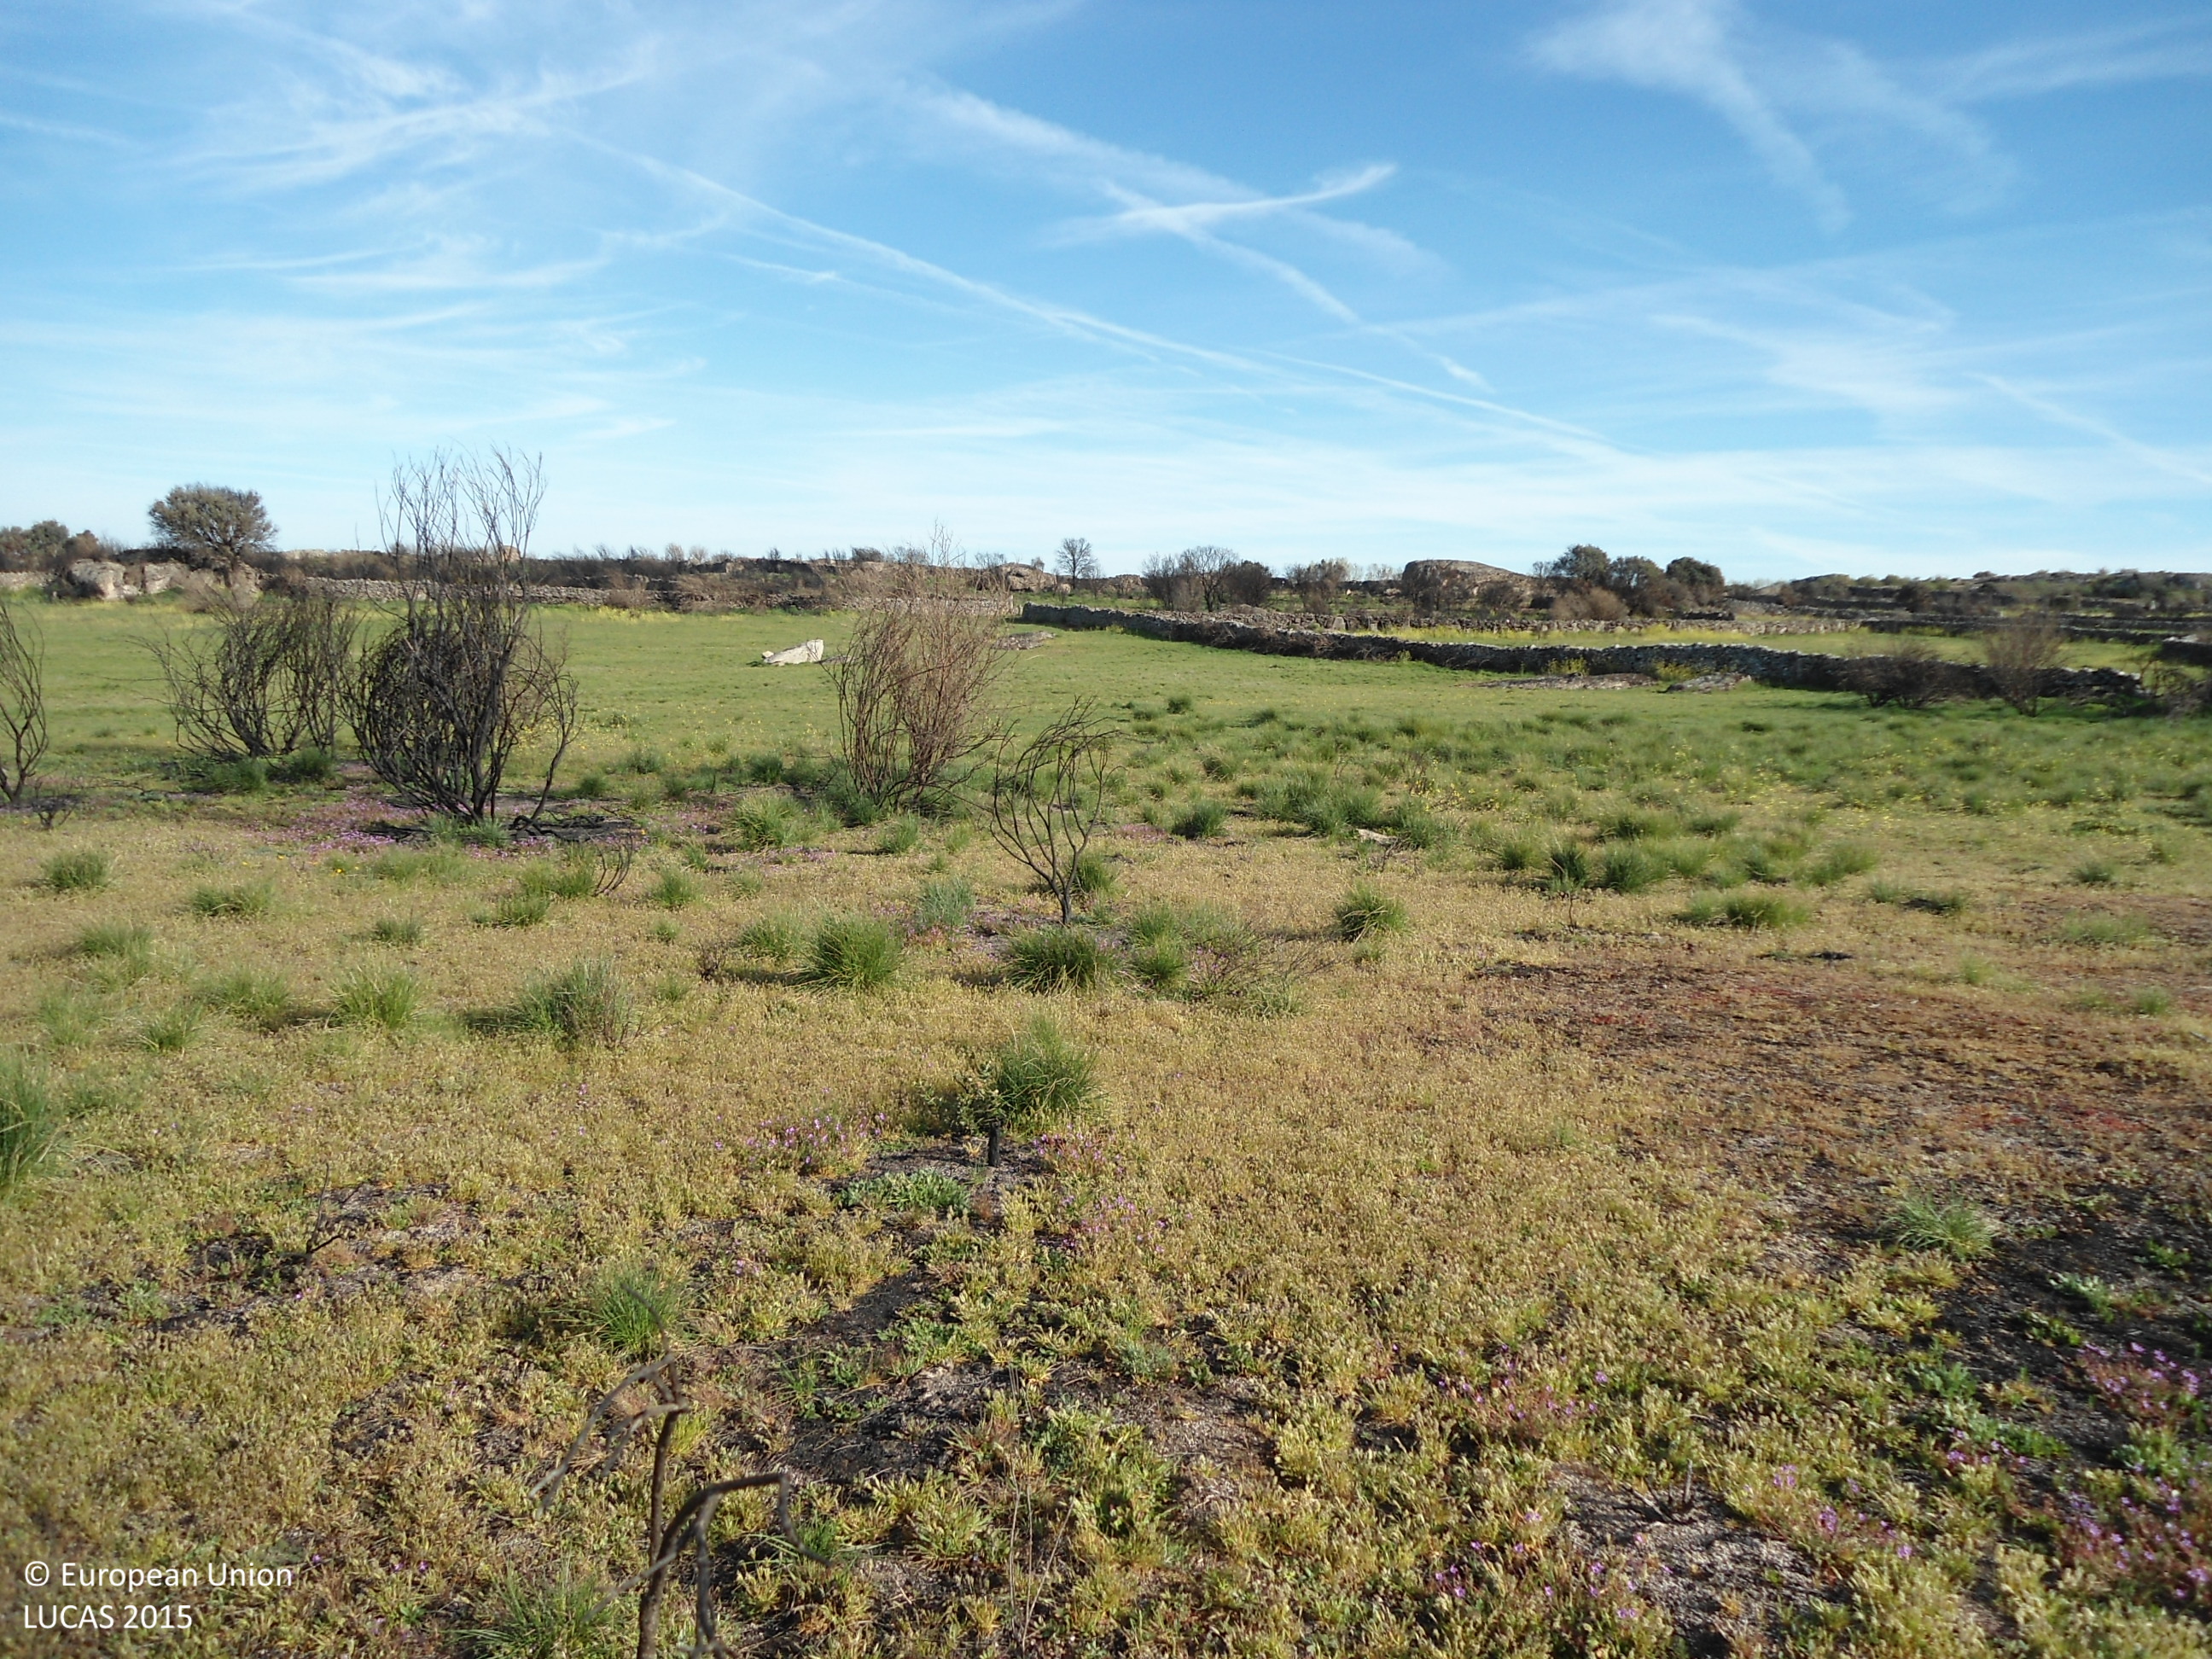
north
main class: Grassland
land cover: Grassland without tree/shrub cover
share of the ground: > 75 %
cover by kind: herbaceous plants 100 %
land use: Agriculture (excluding fallow land and kitchen gardens)
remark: Burnt area
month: April
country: ES
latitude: 41.5267
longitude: -6.0687
